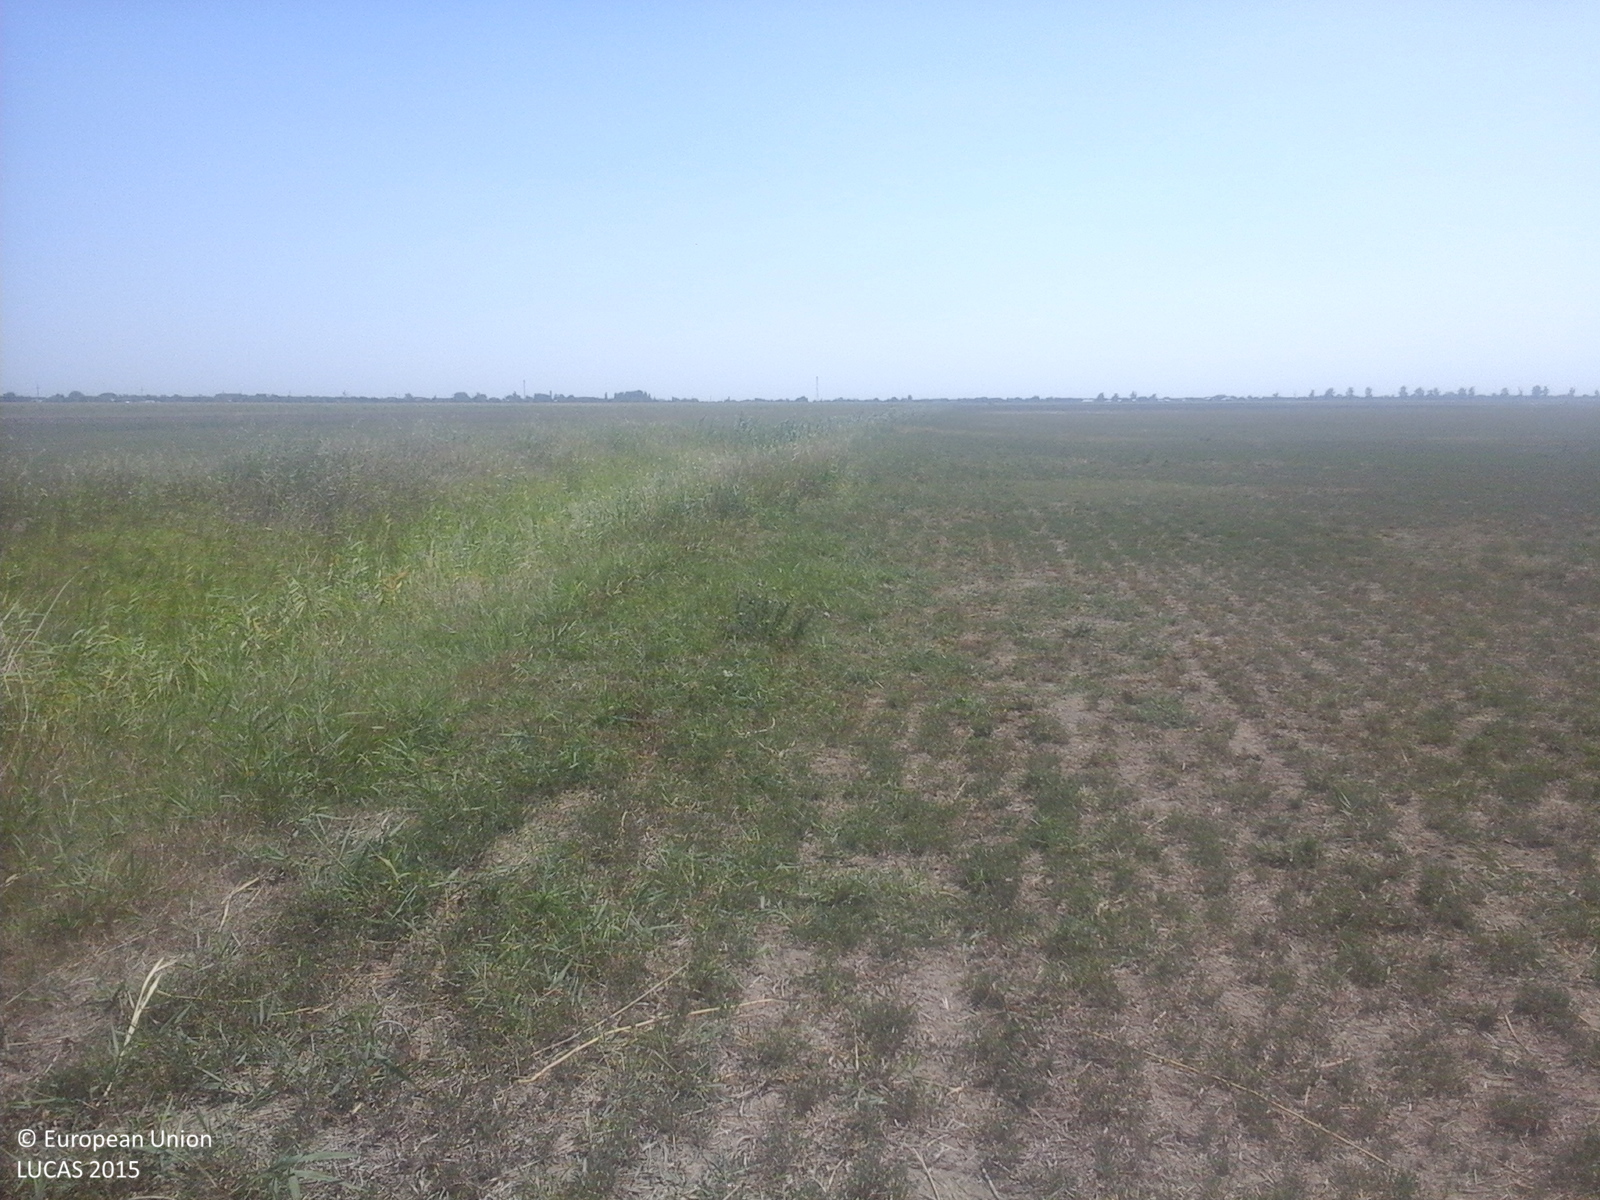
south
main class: Cropland
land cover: Lucerne
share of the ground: 50 - 75 %
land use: Agriculture (excluding fallow land and kitchen gardens)
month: August
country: RO
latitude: 45.5241
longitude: 27.4757
